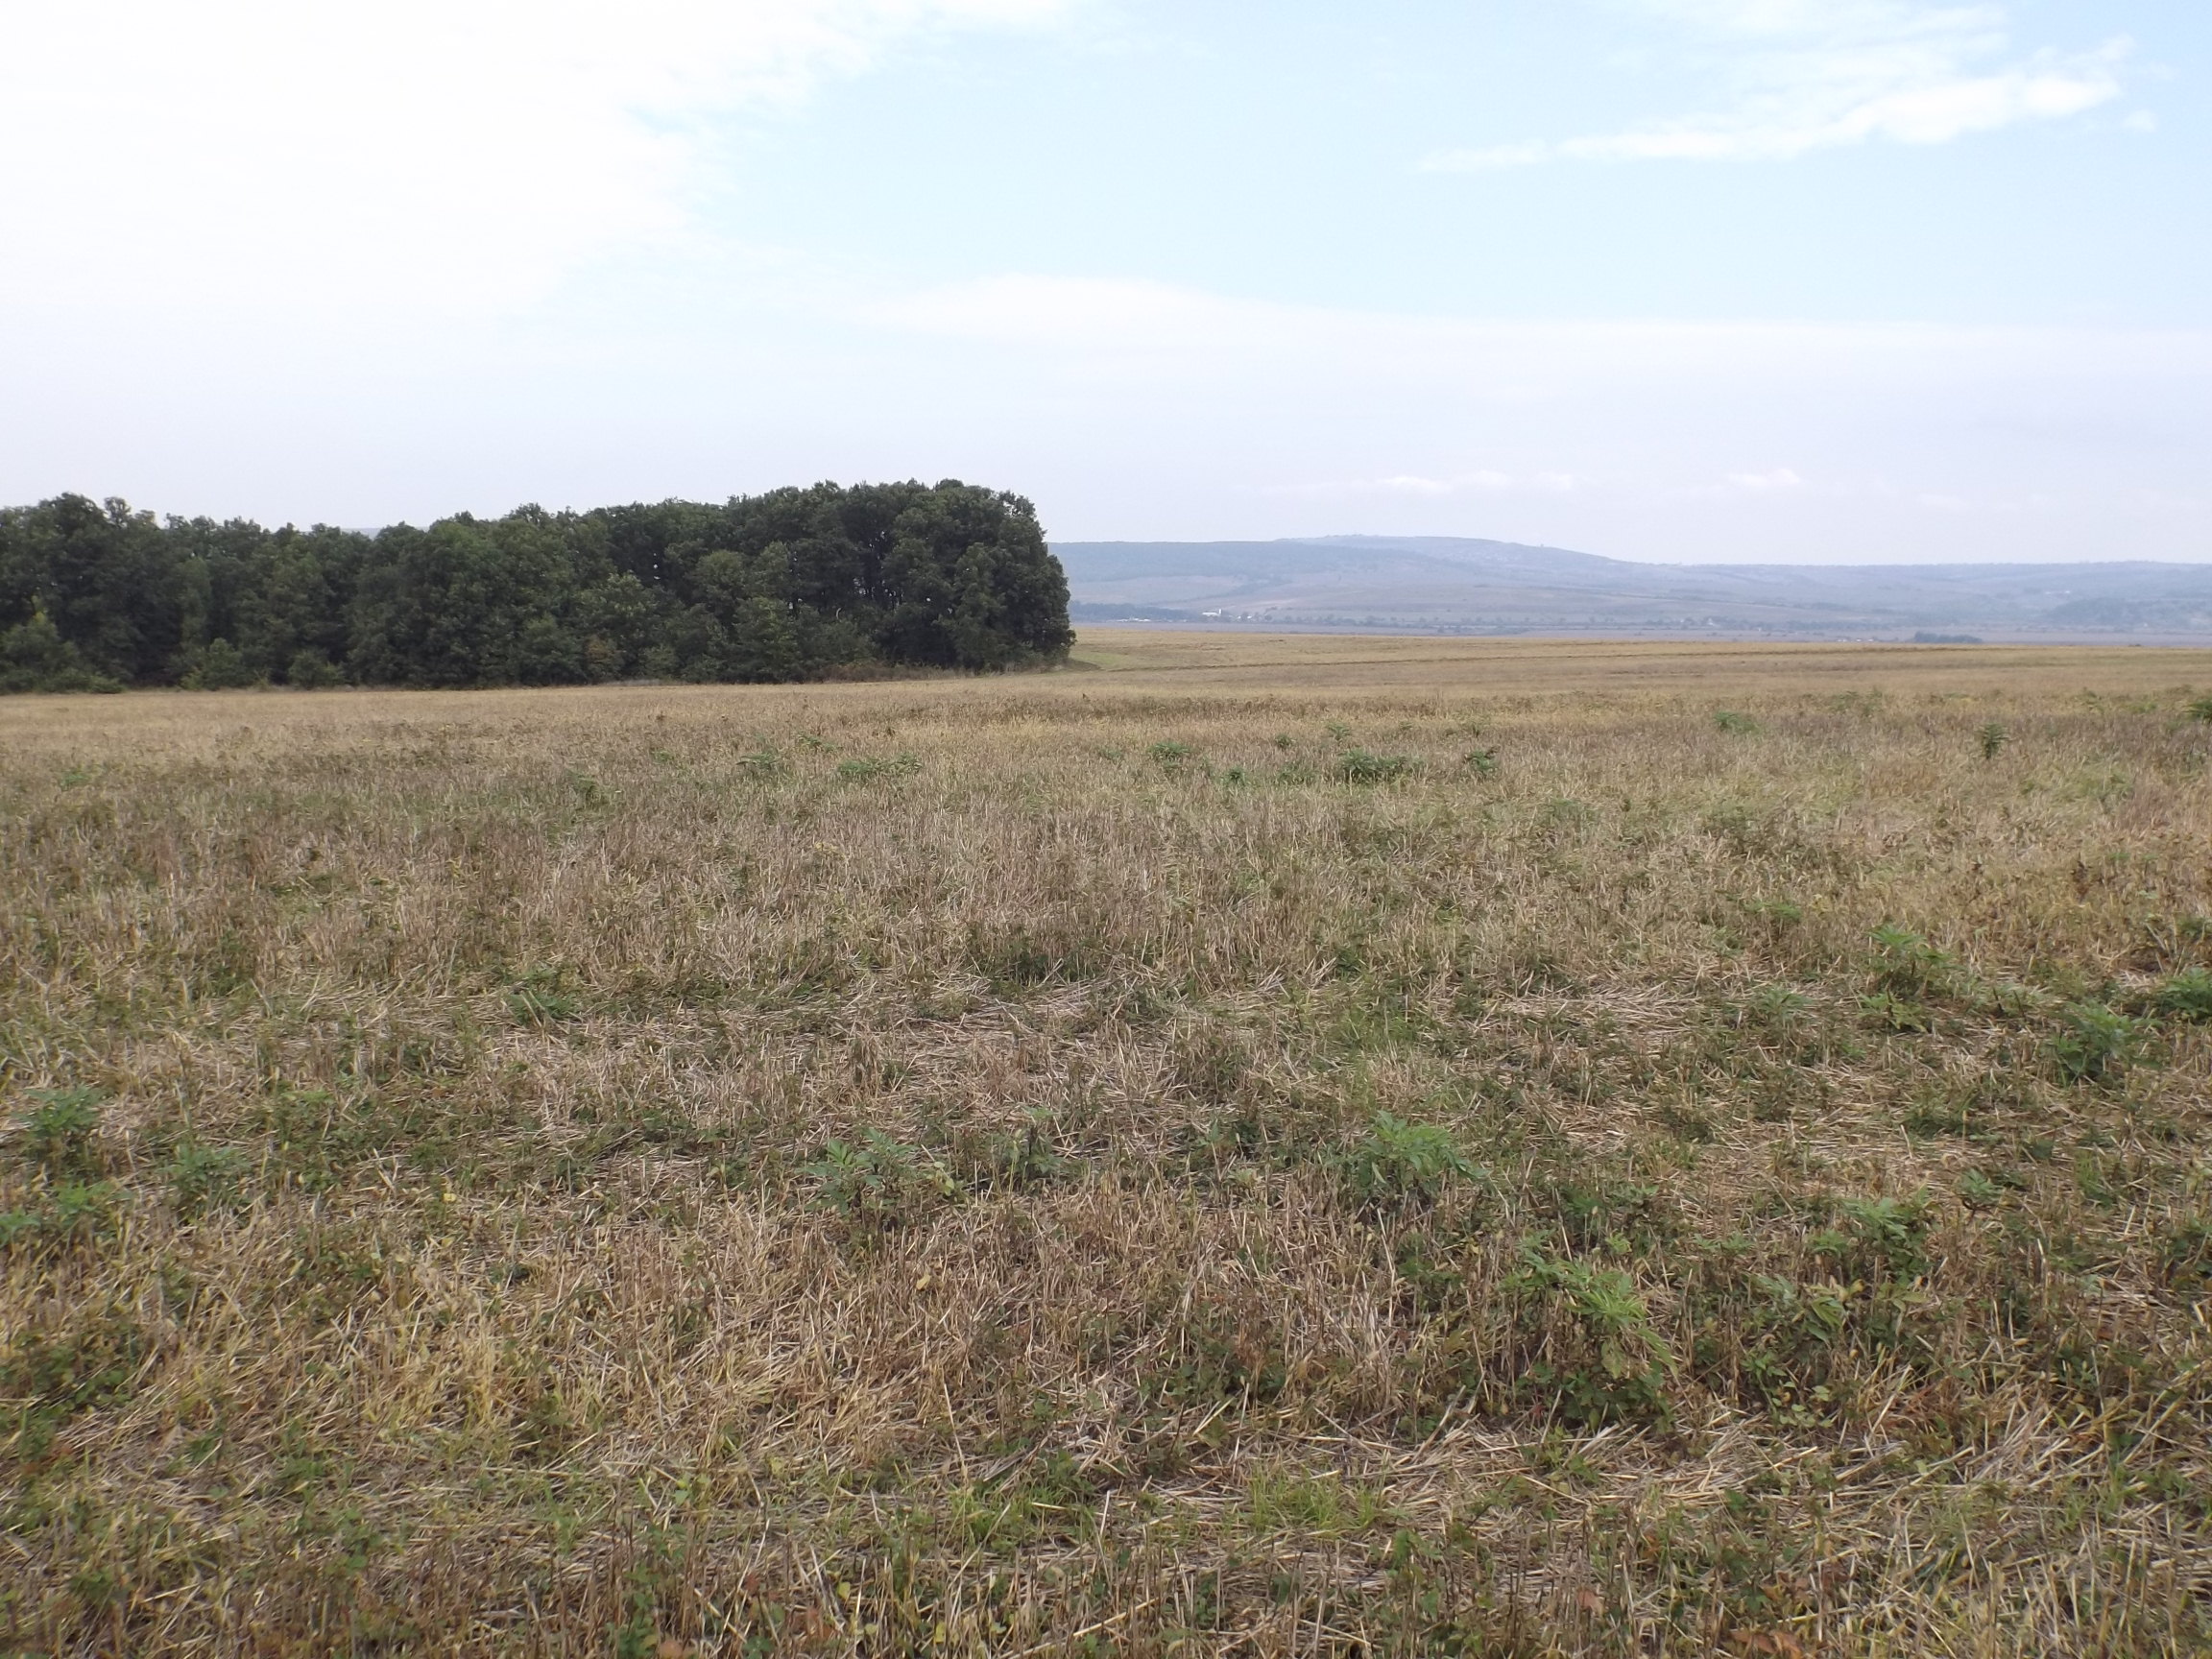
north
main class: Cropland
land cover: Common wheat
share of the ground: 10 - 25 %
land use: Agriculture (excluding fallow land and kitchen gardens)
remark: Harvested field
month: October
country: BG
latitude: 43.0206
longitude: 27.3616
